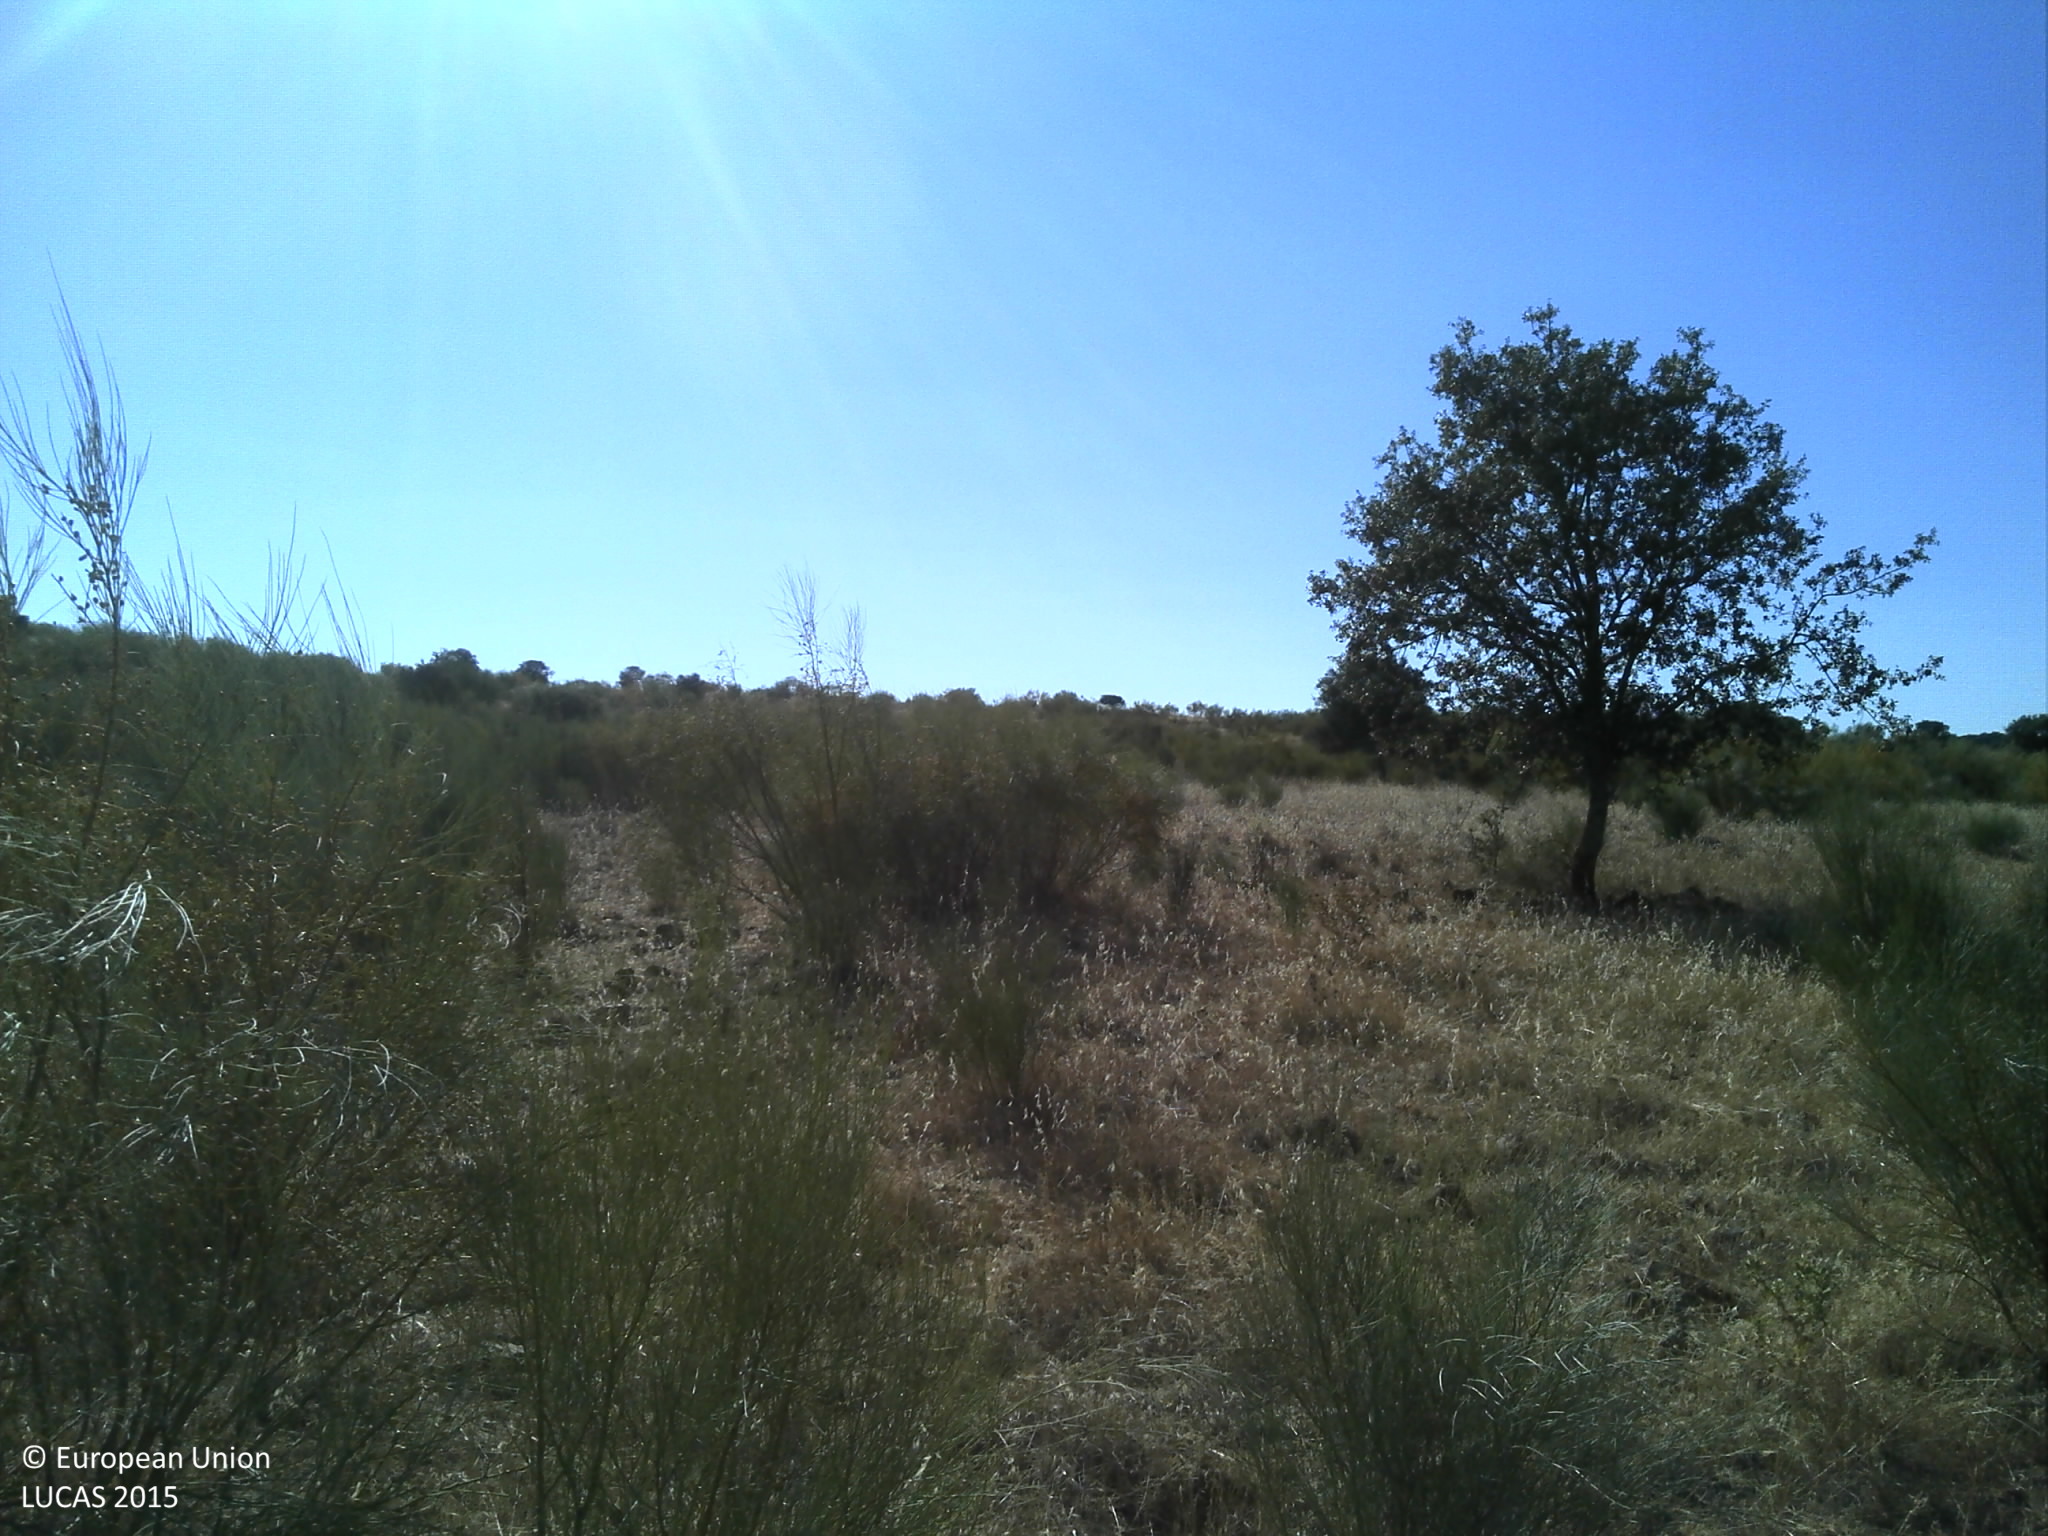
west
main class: Shrubland
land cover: Shrubland with sparse tree cover
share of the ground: 25 - 50 %
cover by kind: unconsolidated bare surface 70 %, shrubs 15 %, herbaceous plants 10 %, broadleaved forest trees 5 %
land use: Agriculture (excluding fallow land and kitchen gardens)
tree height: < 5 m
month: July
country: PT
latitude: 38.9664
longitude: -7.4518
